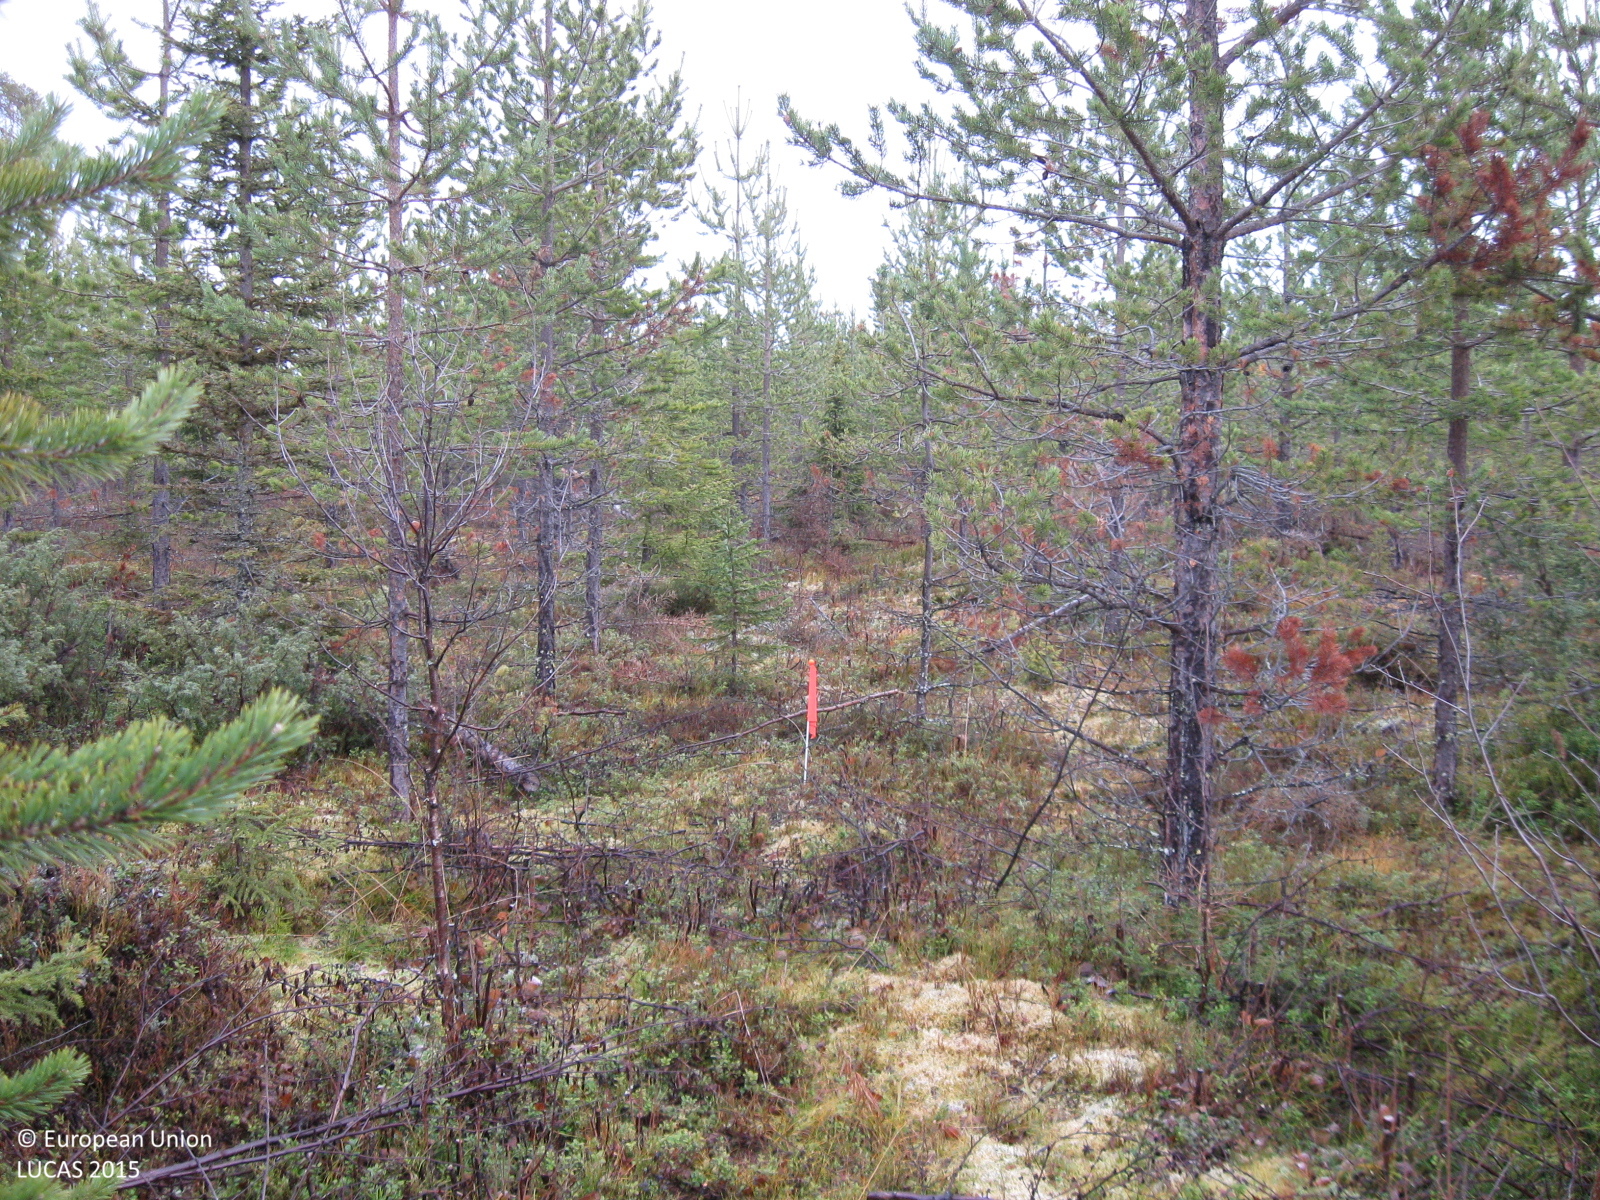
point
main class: Woodland
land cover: Pine dominated coniferous woodland
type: boreal forest
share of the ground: 50 - 75 %
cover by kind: coniferous forest trees 65 %, shrubs 15 %, lichens and mosses 10 %, broadleaved forest trees 5 %, herbaceous plants 5 %
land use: Forestry
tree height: < 5 m
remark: Nursery
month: October
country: SE
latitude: 66.4615
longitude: 21.6099
